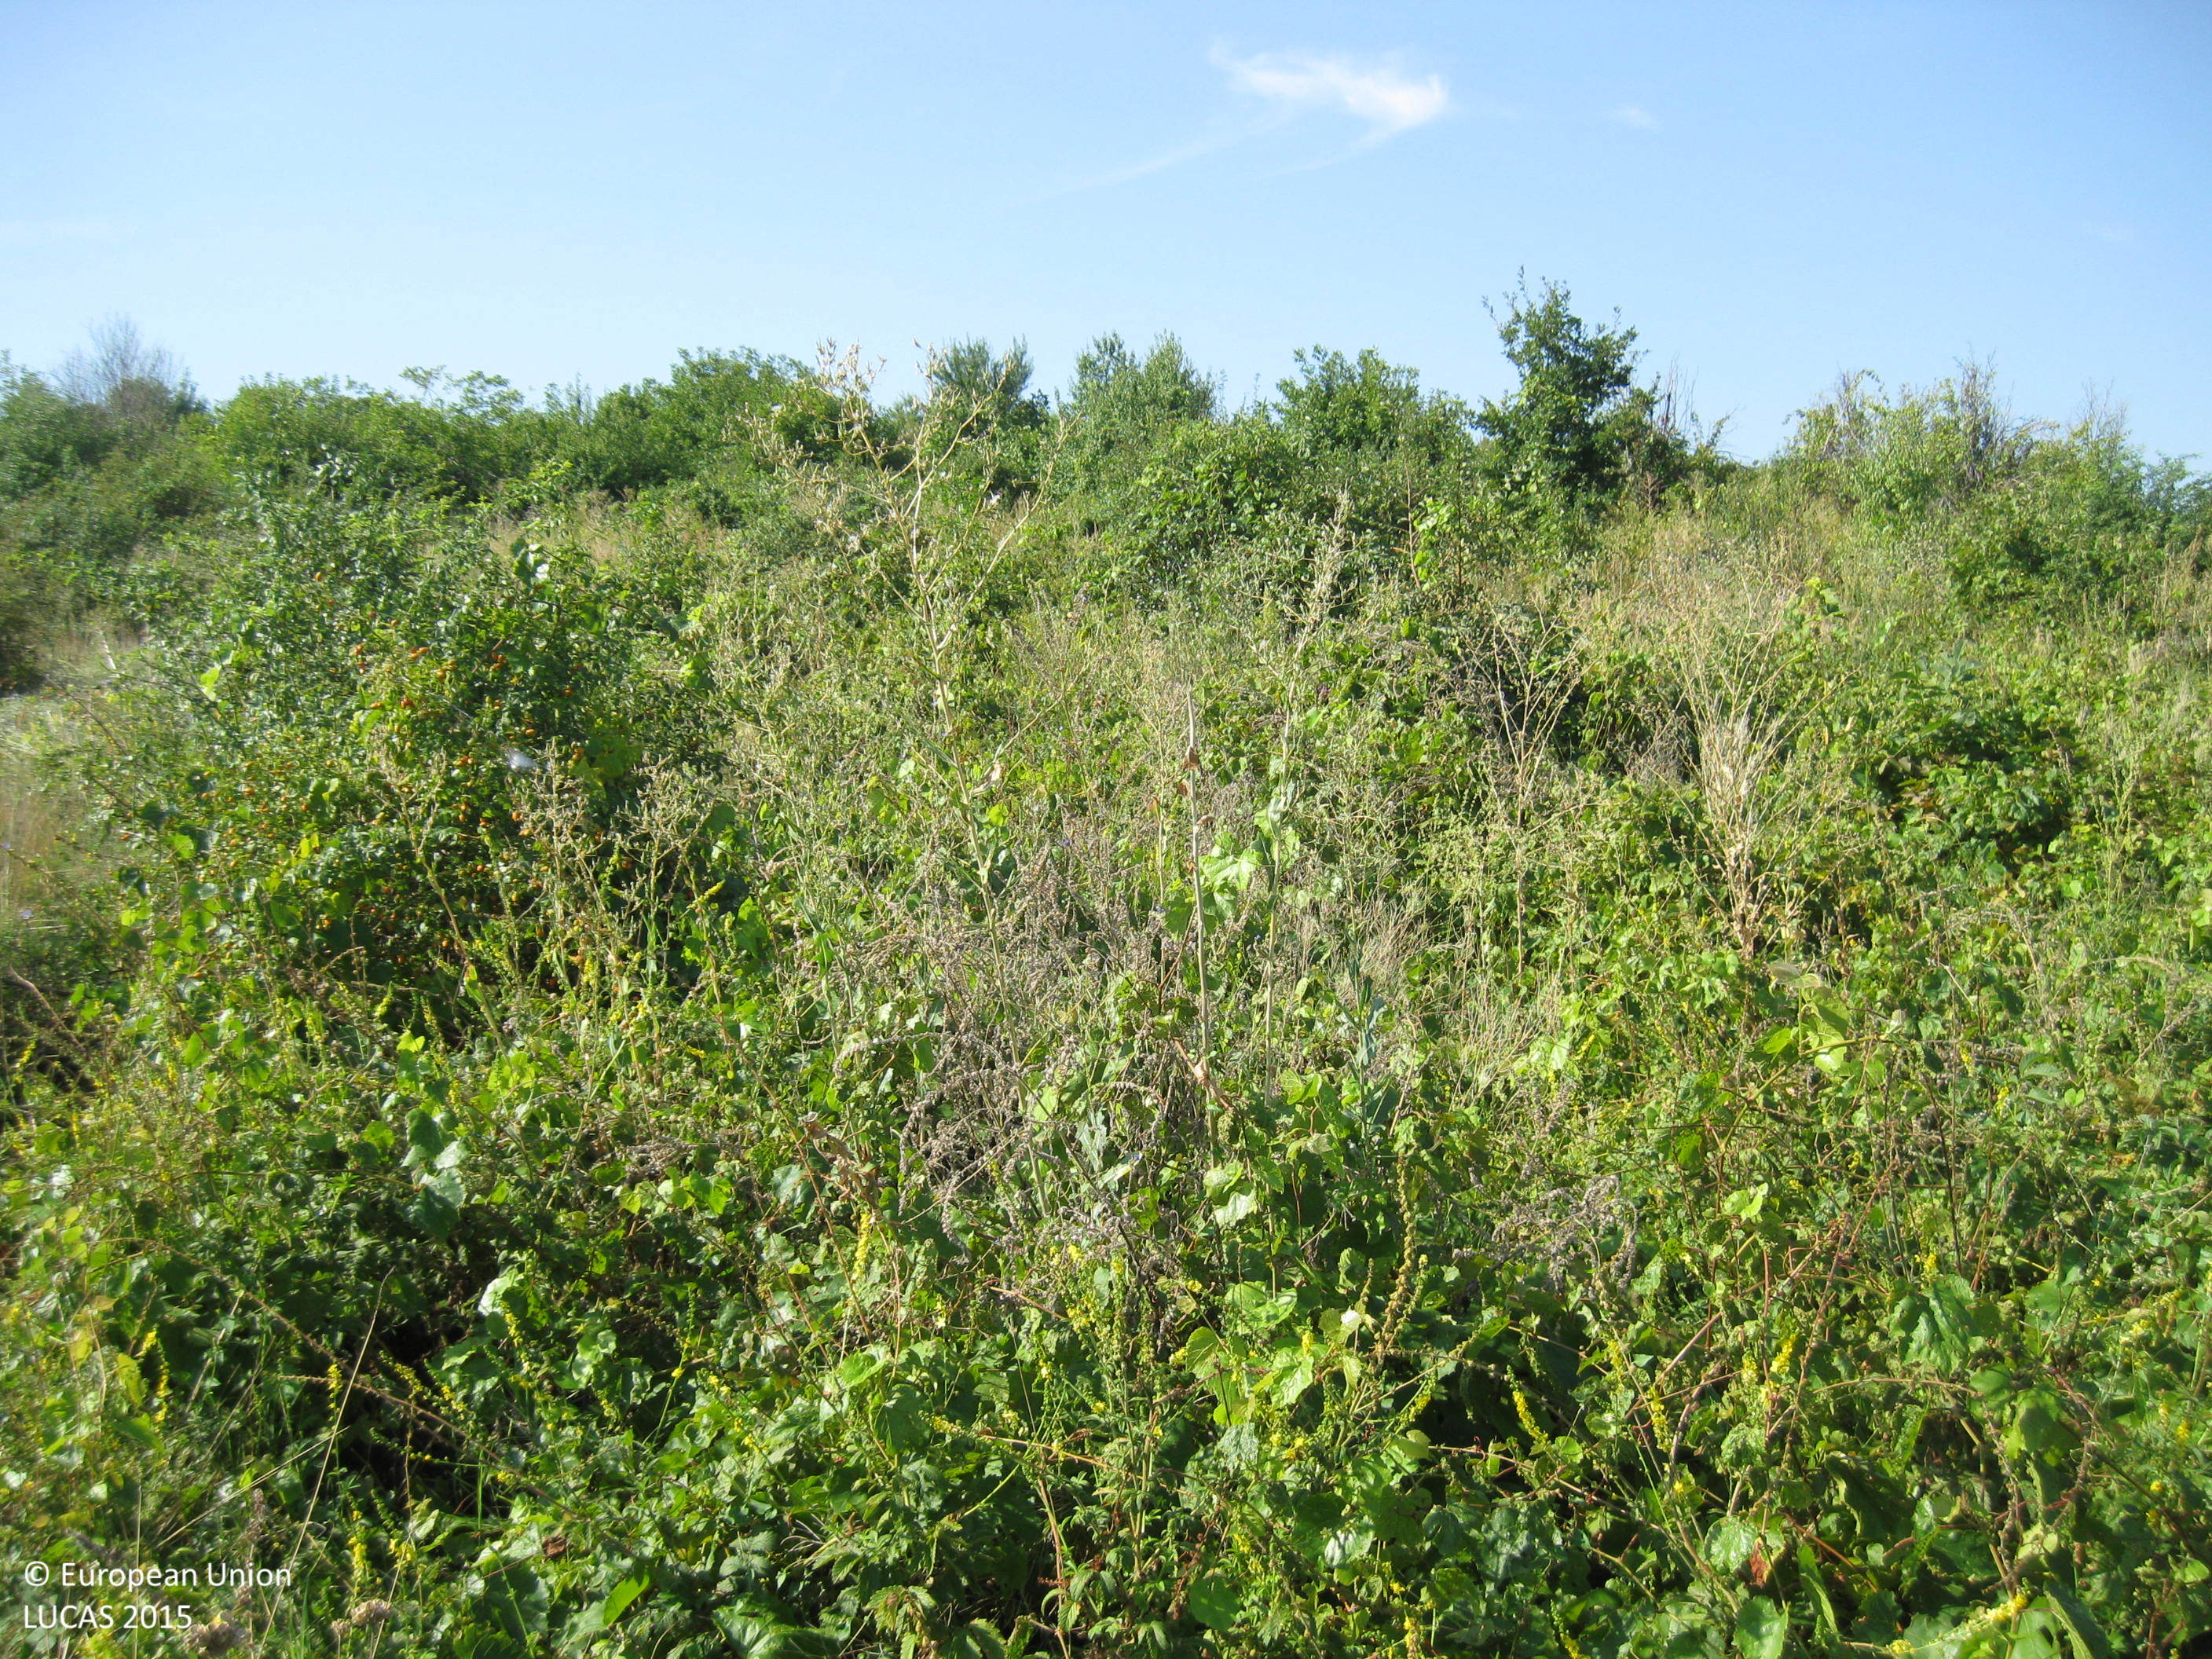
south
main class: Cropland
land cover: Vineyards
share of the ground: > 75 %
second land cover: Spontaneously vegetated surfaces
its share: > 75 %
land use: Agriculture (excluding fallow land and kitchen gardens)
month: August
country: BG
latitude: 42.0187
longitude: 24.9190
